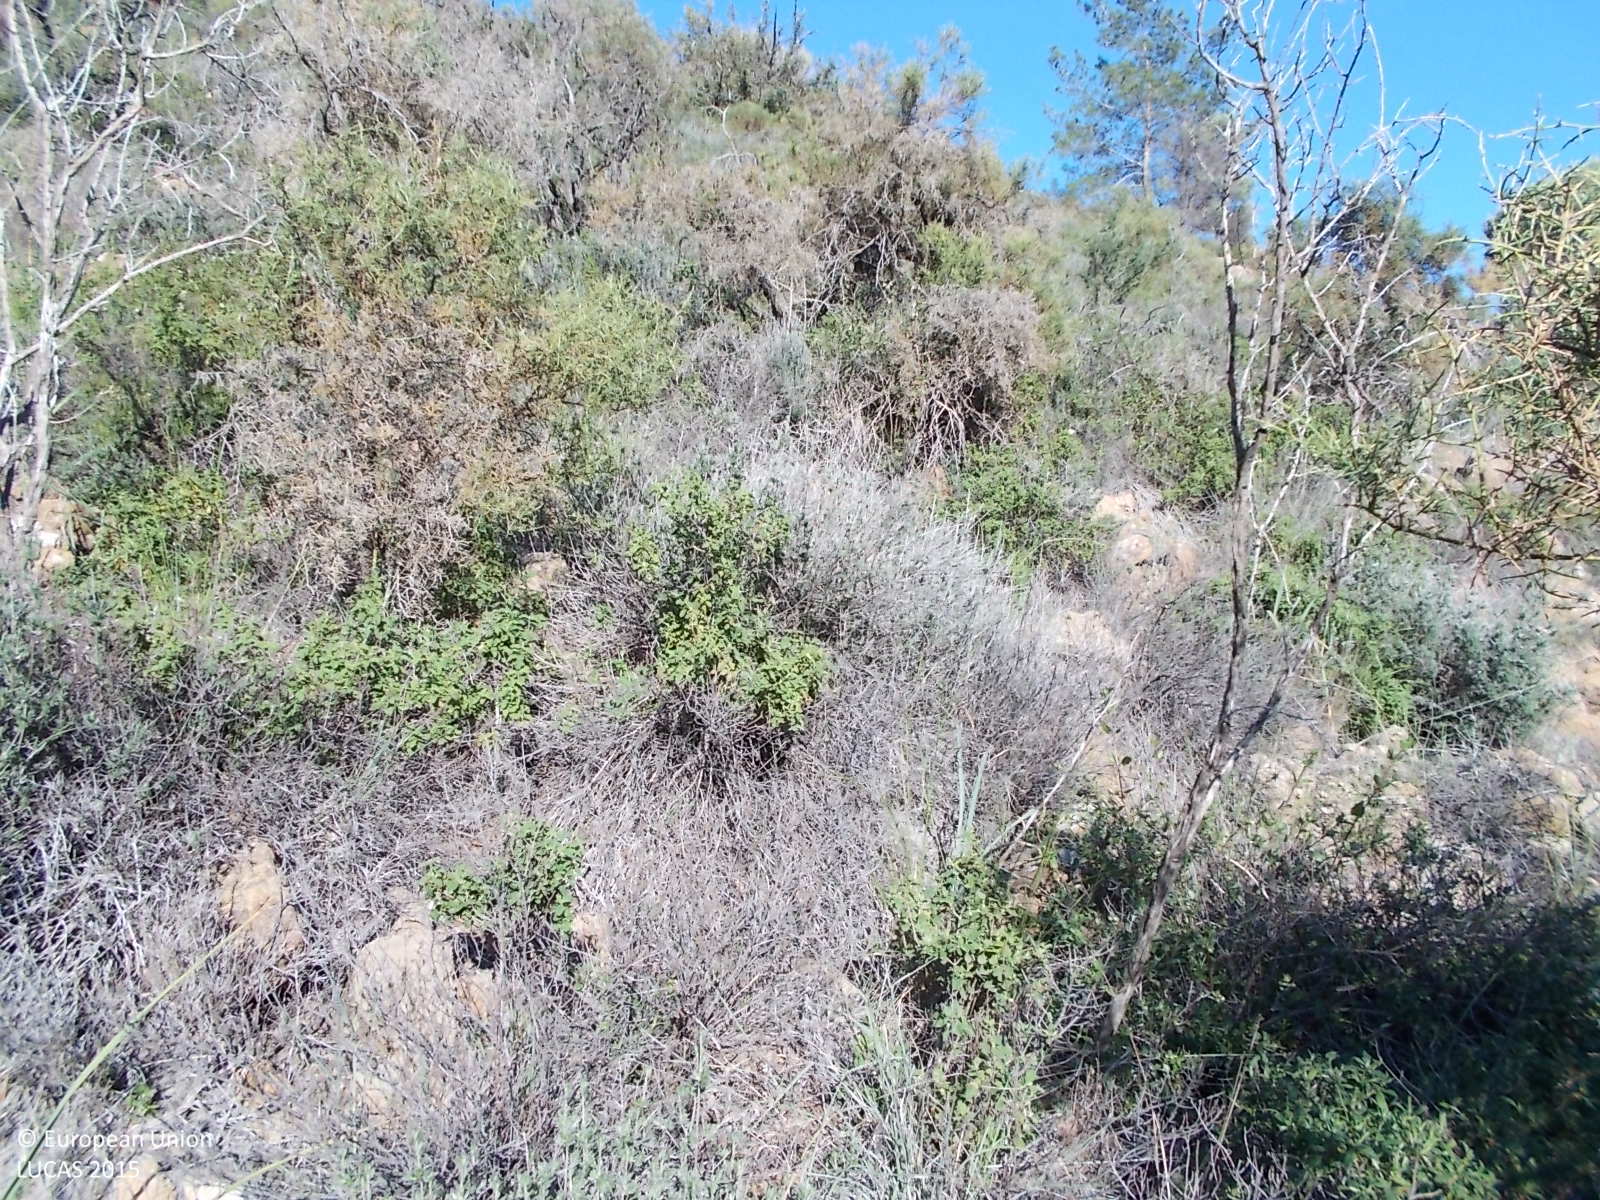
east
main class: Shrubland
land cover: Shrubland without tree cover
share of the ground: > 75 %
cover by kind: shrubs 95 %, herbaceous plants 5 %
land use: Semi-natural and natural areas not in use
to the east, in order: Shrubland without tree cover; Pine dominated coniferous woodland; Rivers and streams; Pine dominated coniferous woodland; Shrubland without tree cover; Shrubland with sparse tree cover
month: April
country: CY
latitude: 34.7793
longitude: 33.1302
